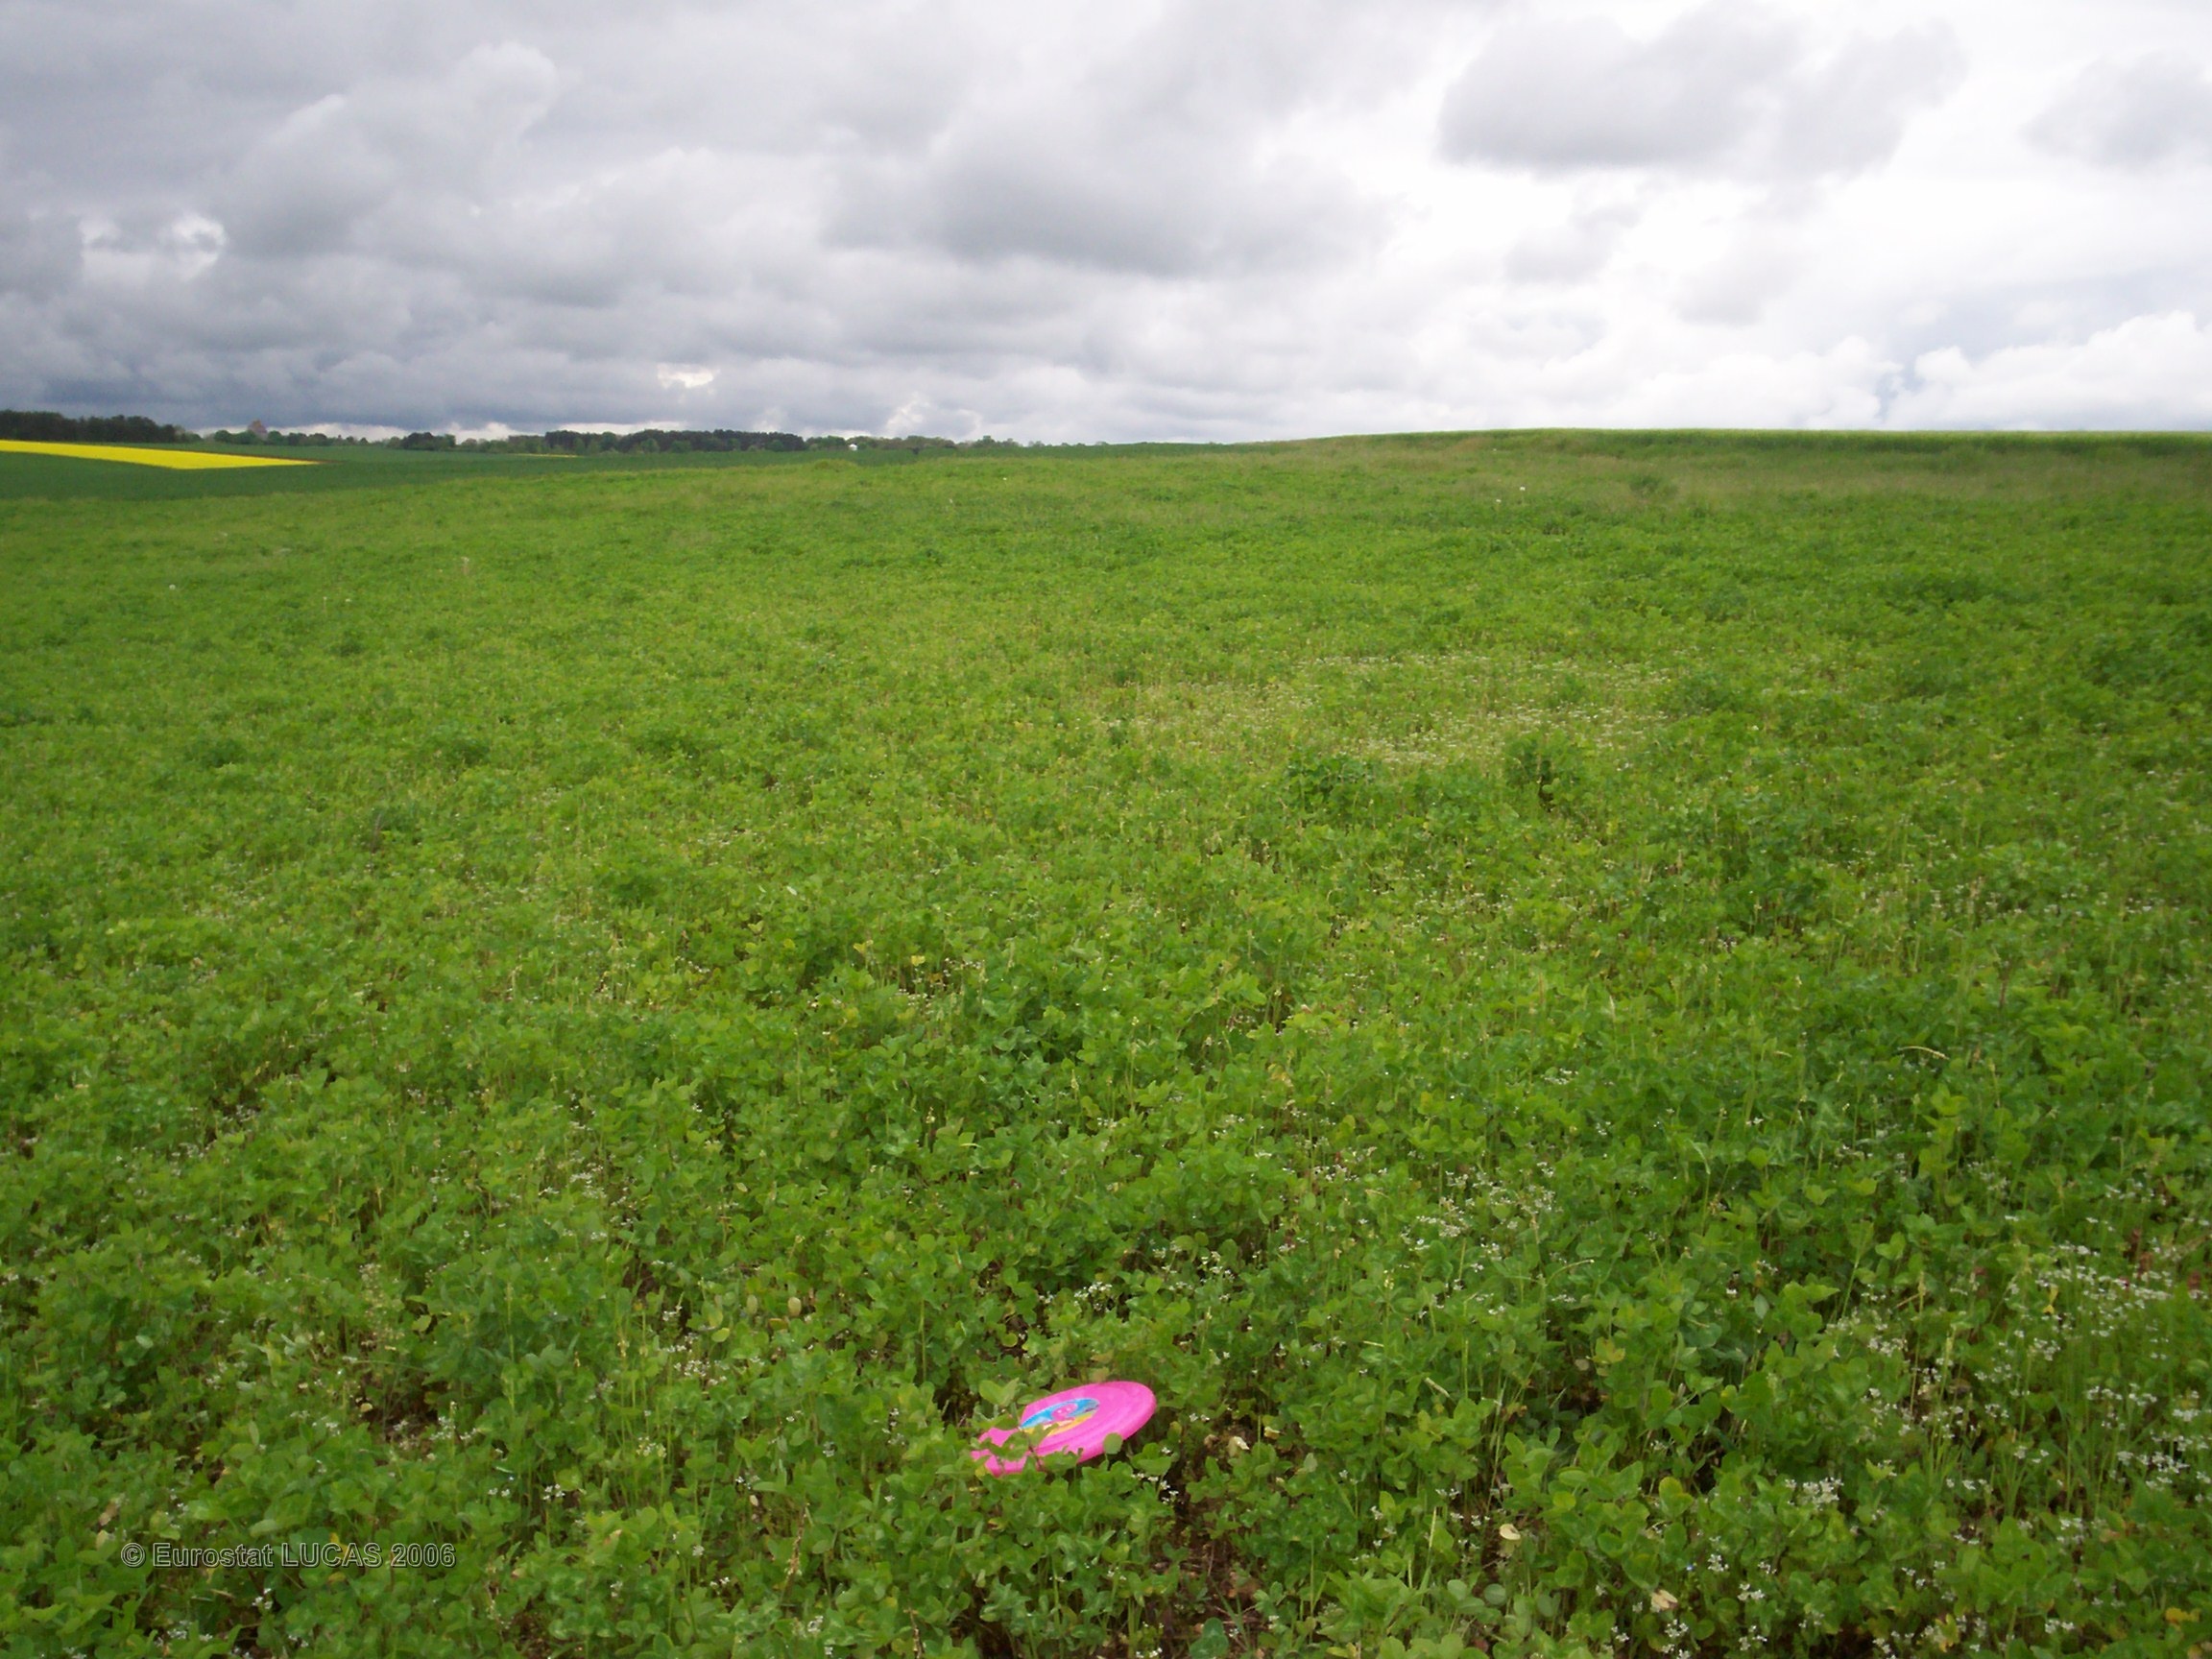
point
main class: Cropland
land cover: Clovers
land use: Agriculture (excluding fallow land and kitchen gardens)
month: May
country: FR
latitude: 47.5649
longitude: 5.3085
